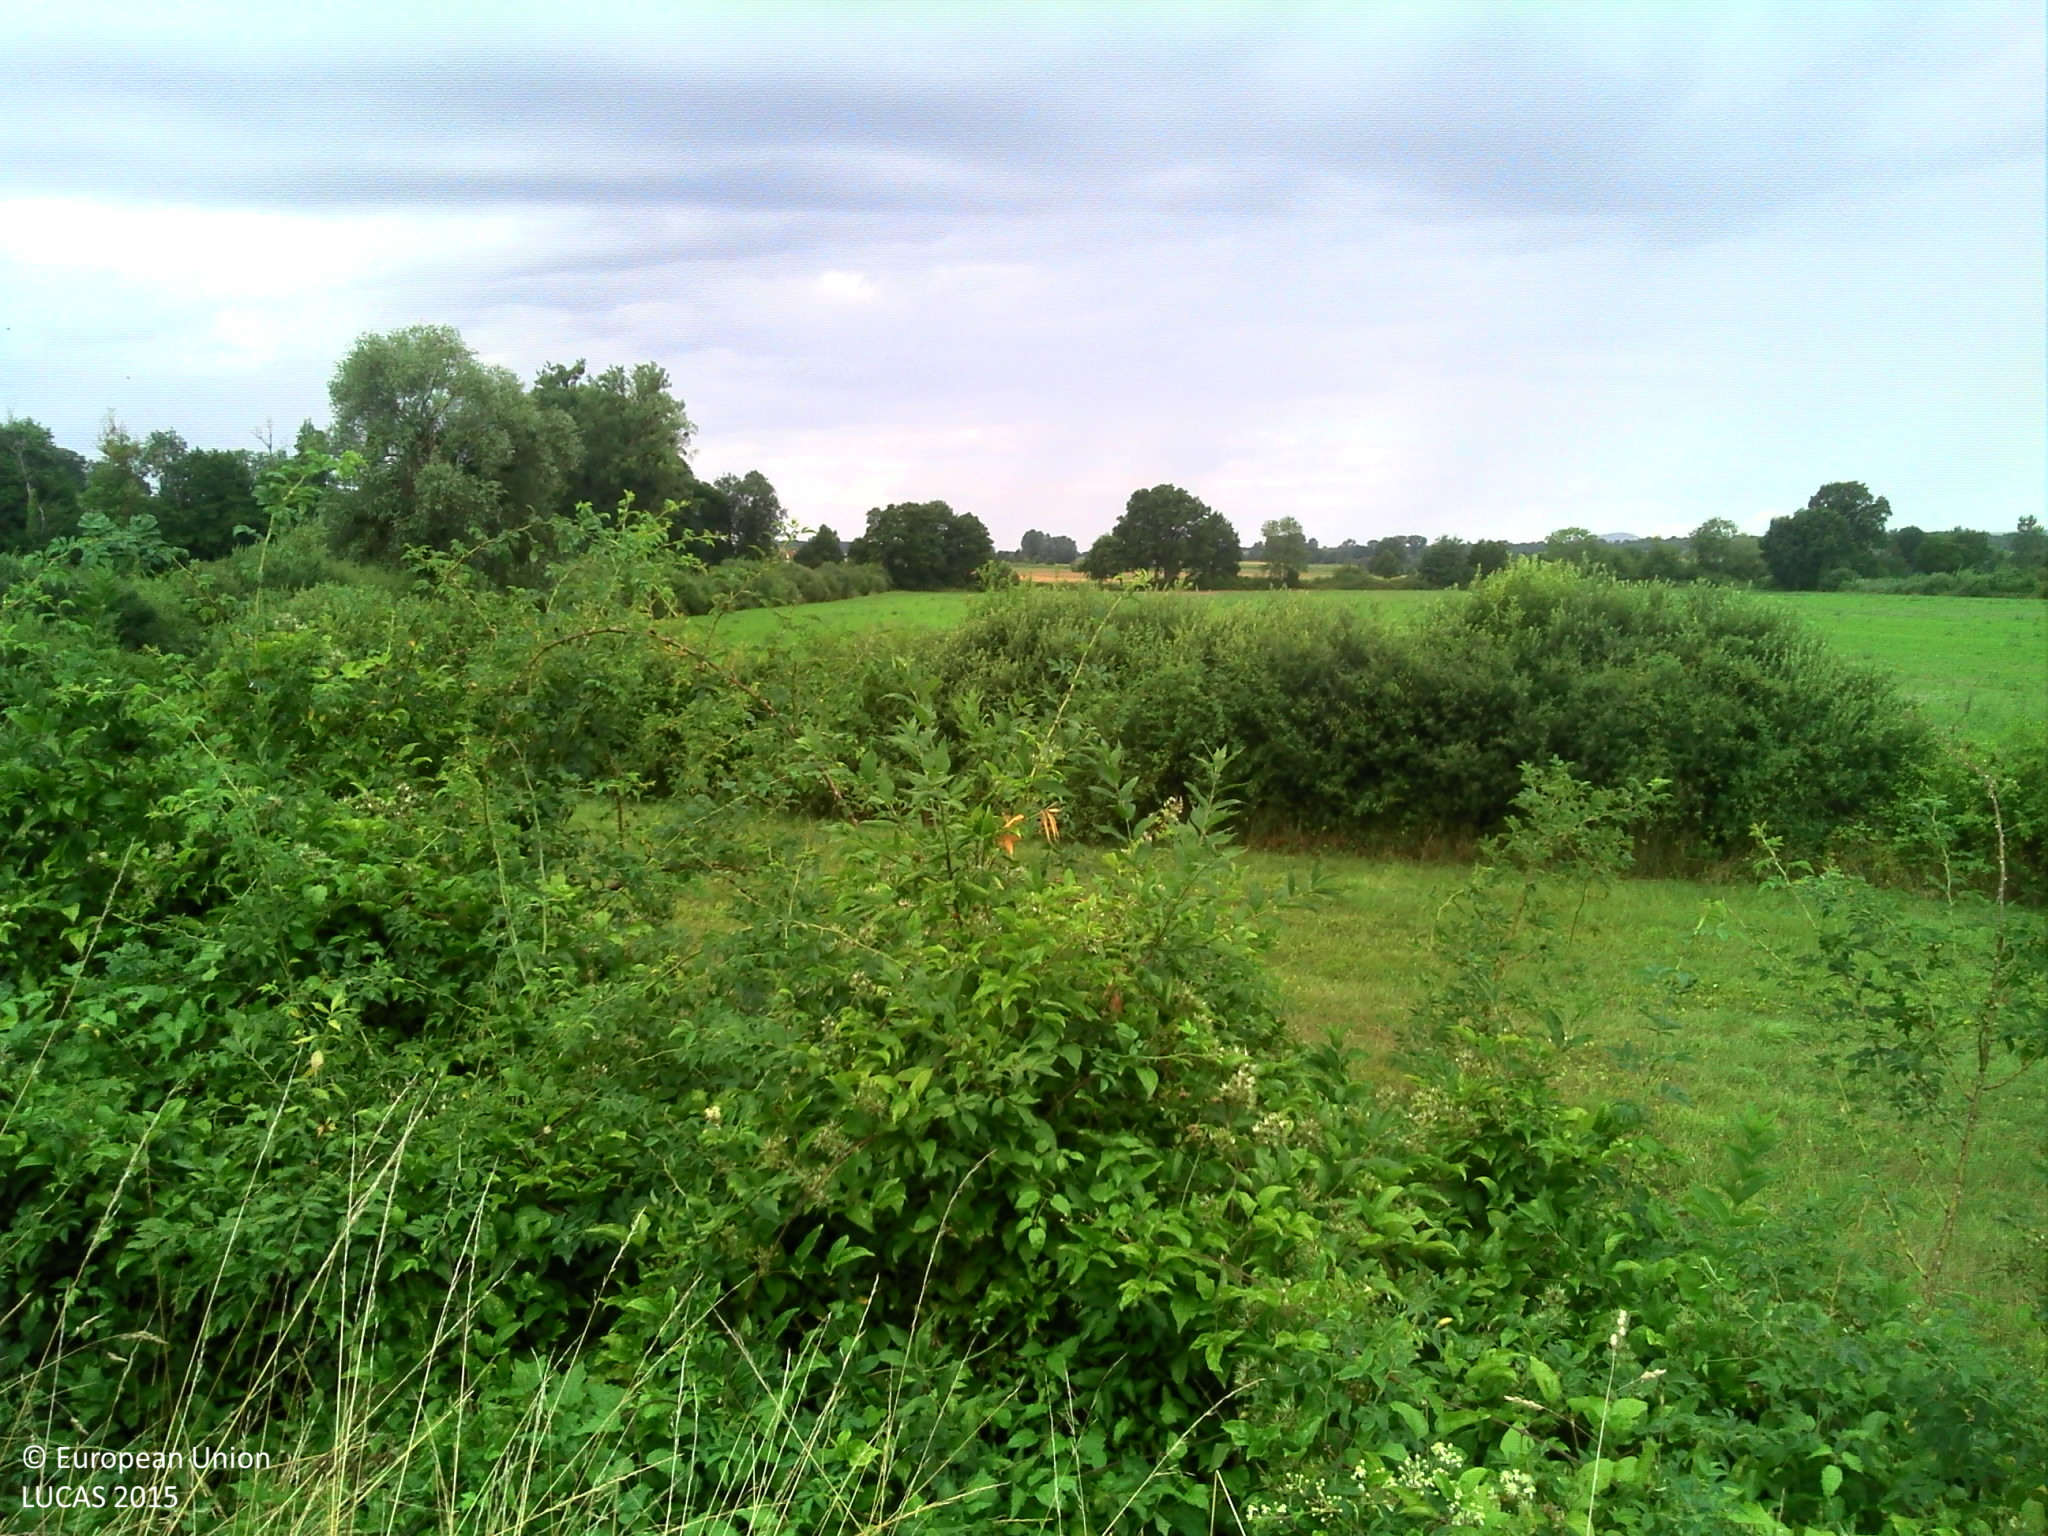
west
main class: Grassland
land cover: Grassland without tree/shrub cover
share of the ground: > 75 %
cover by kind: herbaceous plants 100 %
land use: Semi-natural and natural areas not in use
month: July
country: FR
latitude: 48.8851
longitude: 7.7778
